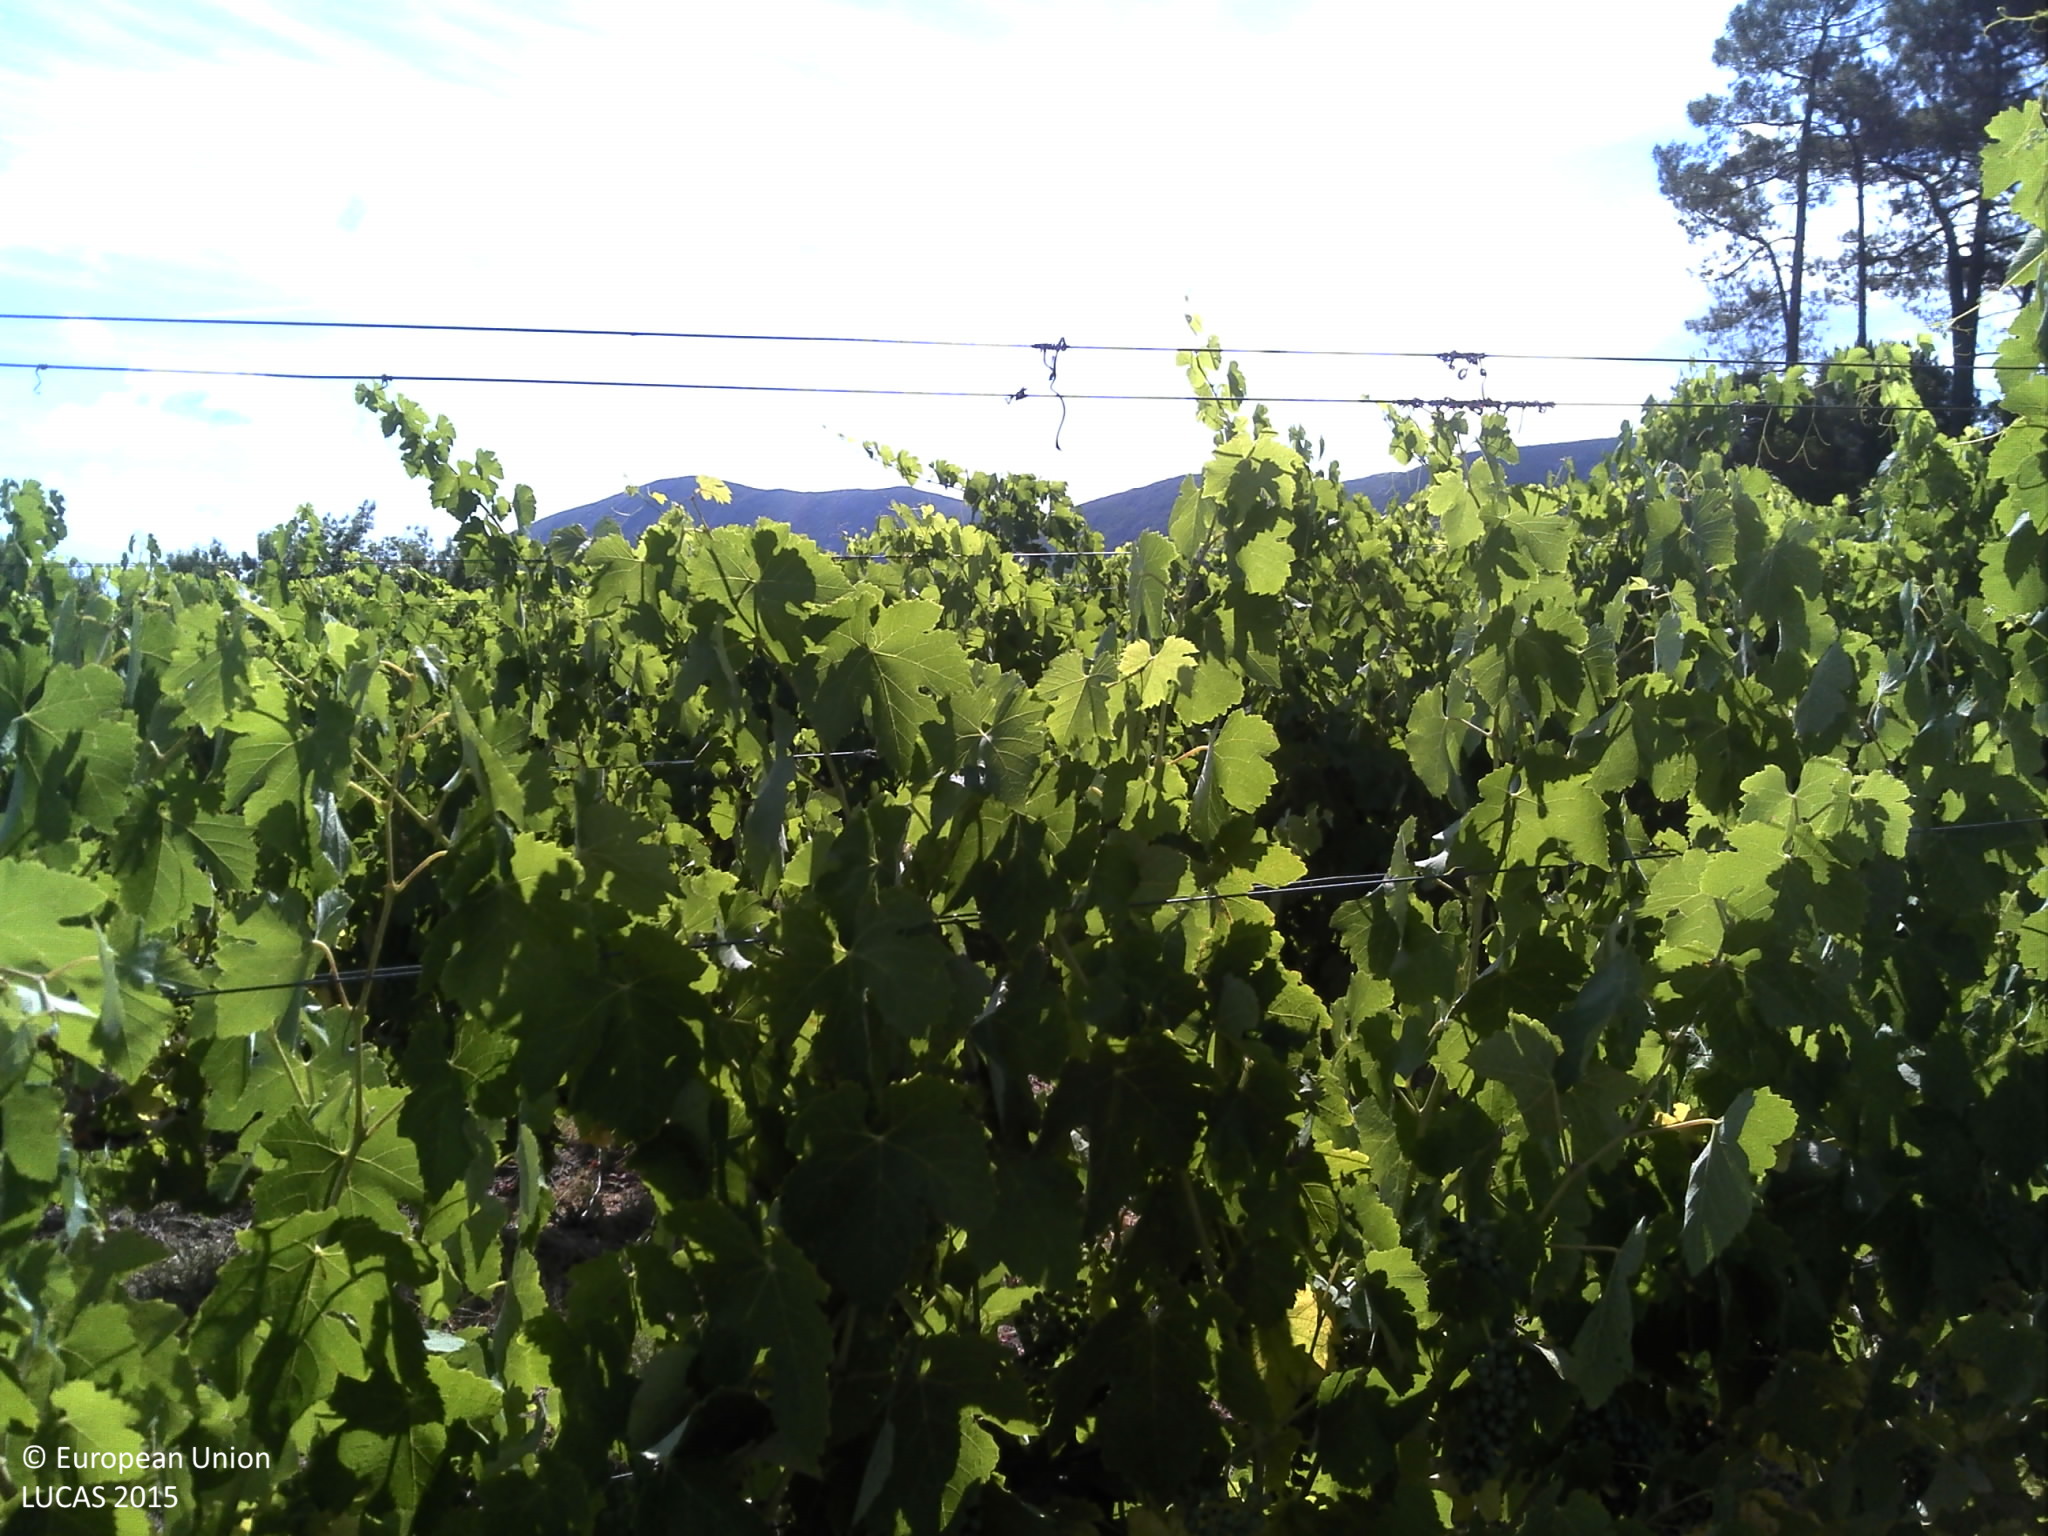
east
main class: Cropland
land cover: Vineyards
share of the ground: 50 - 75 %
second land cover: Grassland without tree/shrub cover
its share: 25 - 50 %
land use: Agriculture (excluding fallow land and kitchen gardens)
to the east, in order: Vineyards; Grassland without tree/shrub cover; Vineyards; Tracks; Abandoned hedges; Rivers and streams; Shruby margins; Spontaneously vegetated surfaces; Fences; Shrubland without tree cover; Grass margins; Electric lines; Tracks; Fences; Pine dominated coniferous woodland; Broadleaved woodland
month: July
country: PT
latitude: 38.4762
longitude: -9.0379
